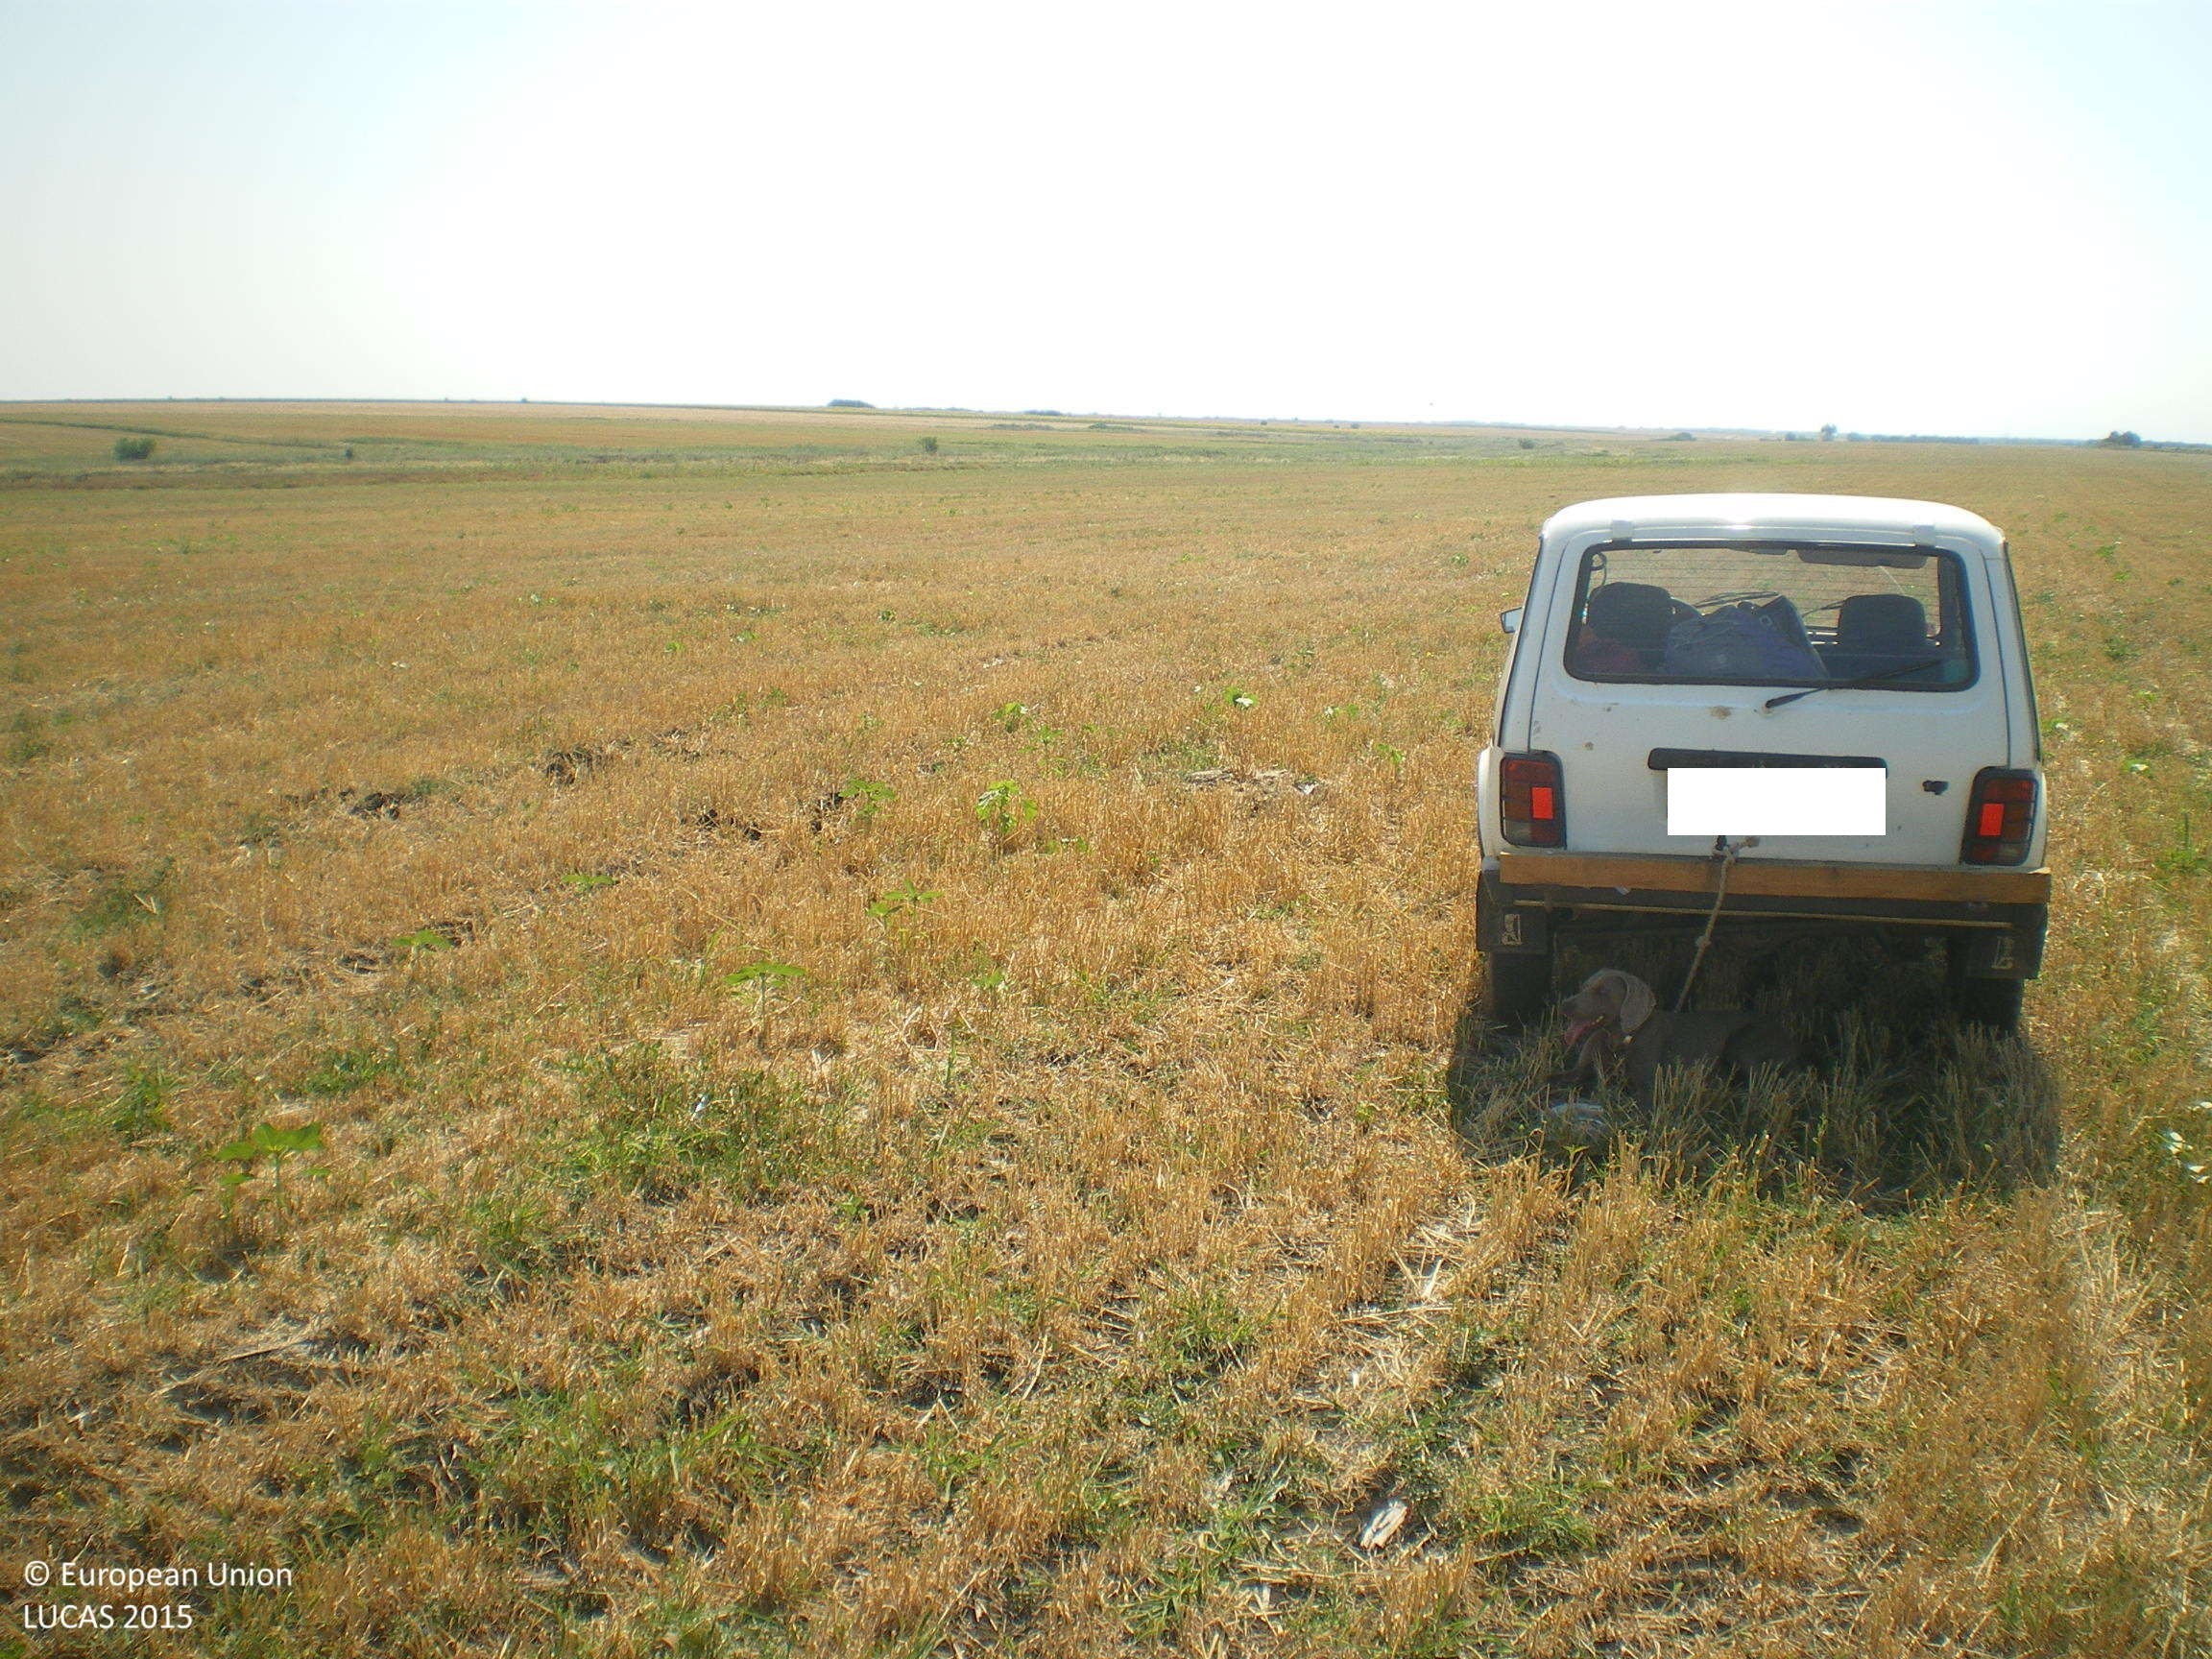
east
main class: Cropland
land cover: Common wheat
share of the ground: 10 - 25 %
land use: Agriculture (excluding fallow land and kitchen gardens)
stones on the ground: < 10 %
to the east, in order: Common wheat; Grassland without tree/shrub cover
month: July
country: BG
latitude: 42.2305
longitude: 25.6891
